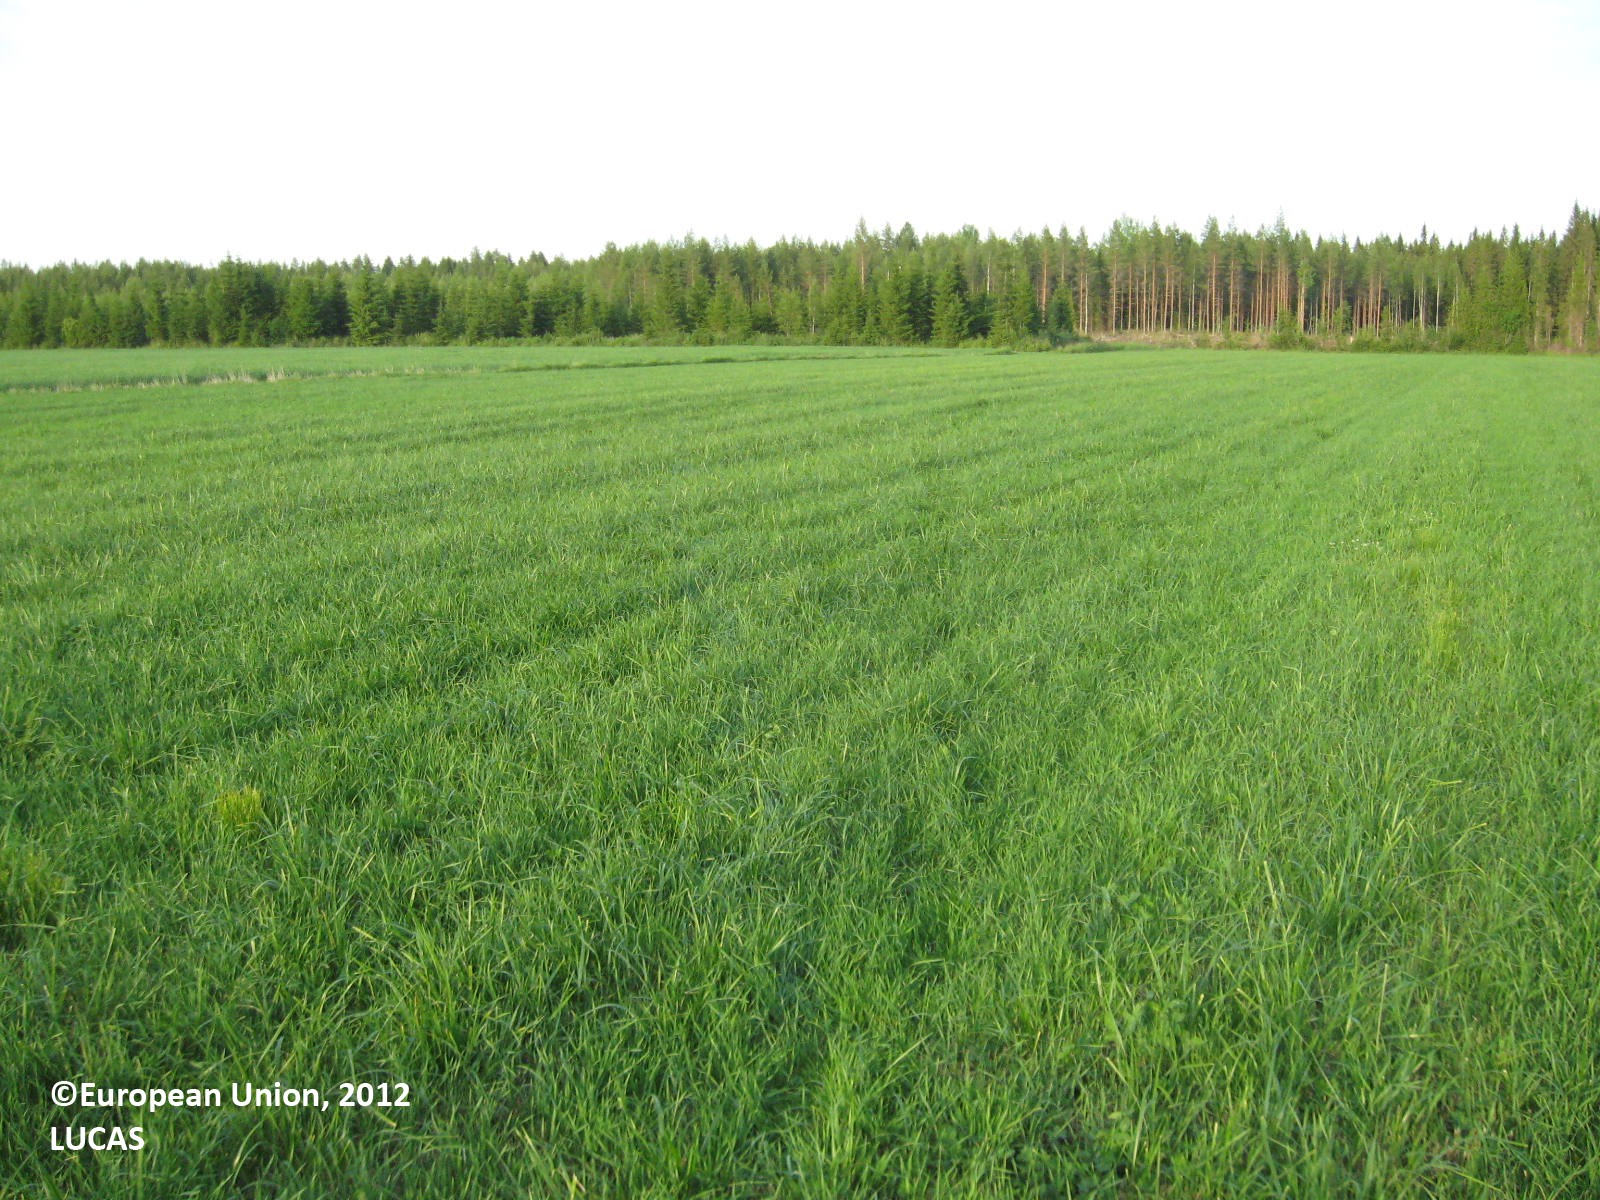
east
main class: Cropland
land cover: Temporary grasslands
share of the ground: > 75 %
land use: Agriculture (excluding fallow land and kitchen gardens)
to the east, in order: Temporary grasslands; Grass margins; Barley; Ditches and canals; Spruce dominated coniferous woodland; Other bare soil
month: July
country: FI
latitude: 62.5775
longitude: 21.6640
